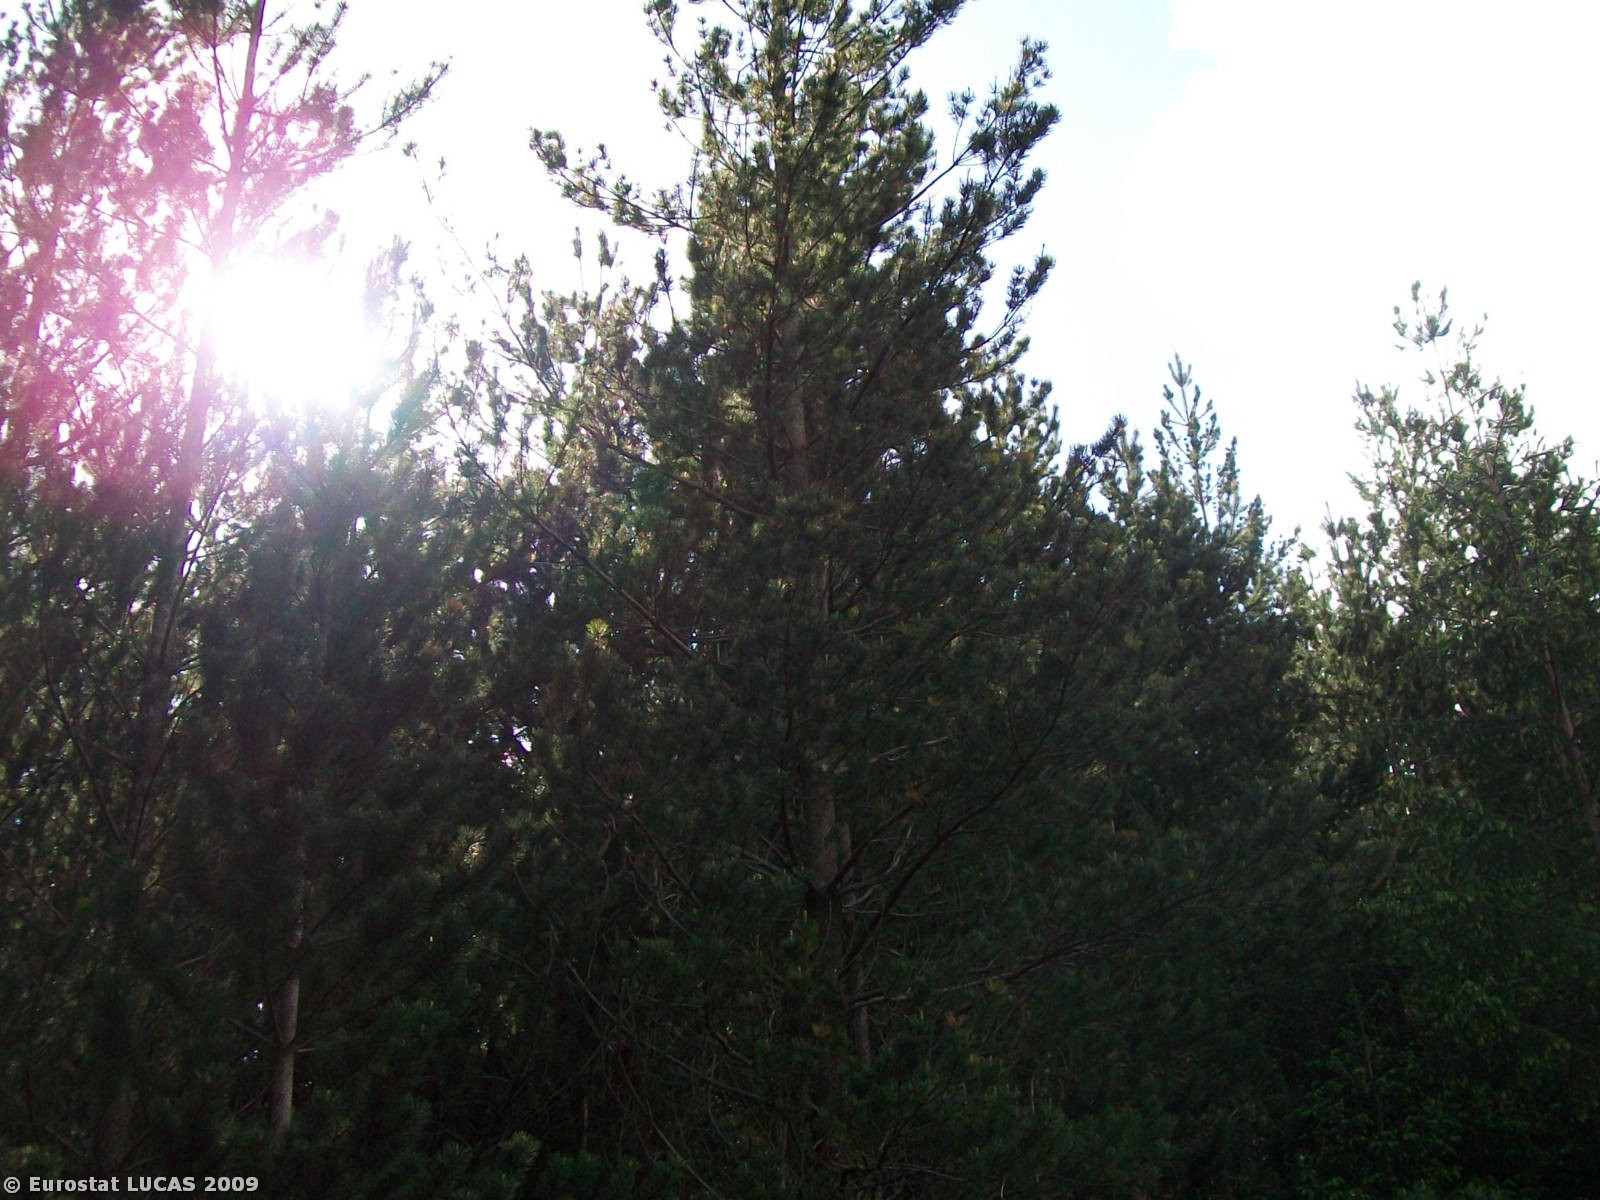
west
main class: Shrubland
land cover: Shrubland without tree cover
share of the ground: 25 - 50 %
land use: Forestry
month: May
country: GB
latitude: 56.8974
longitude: -5.4341
